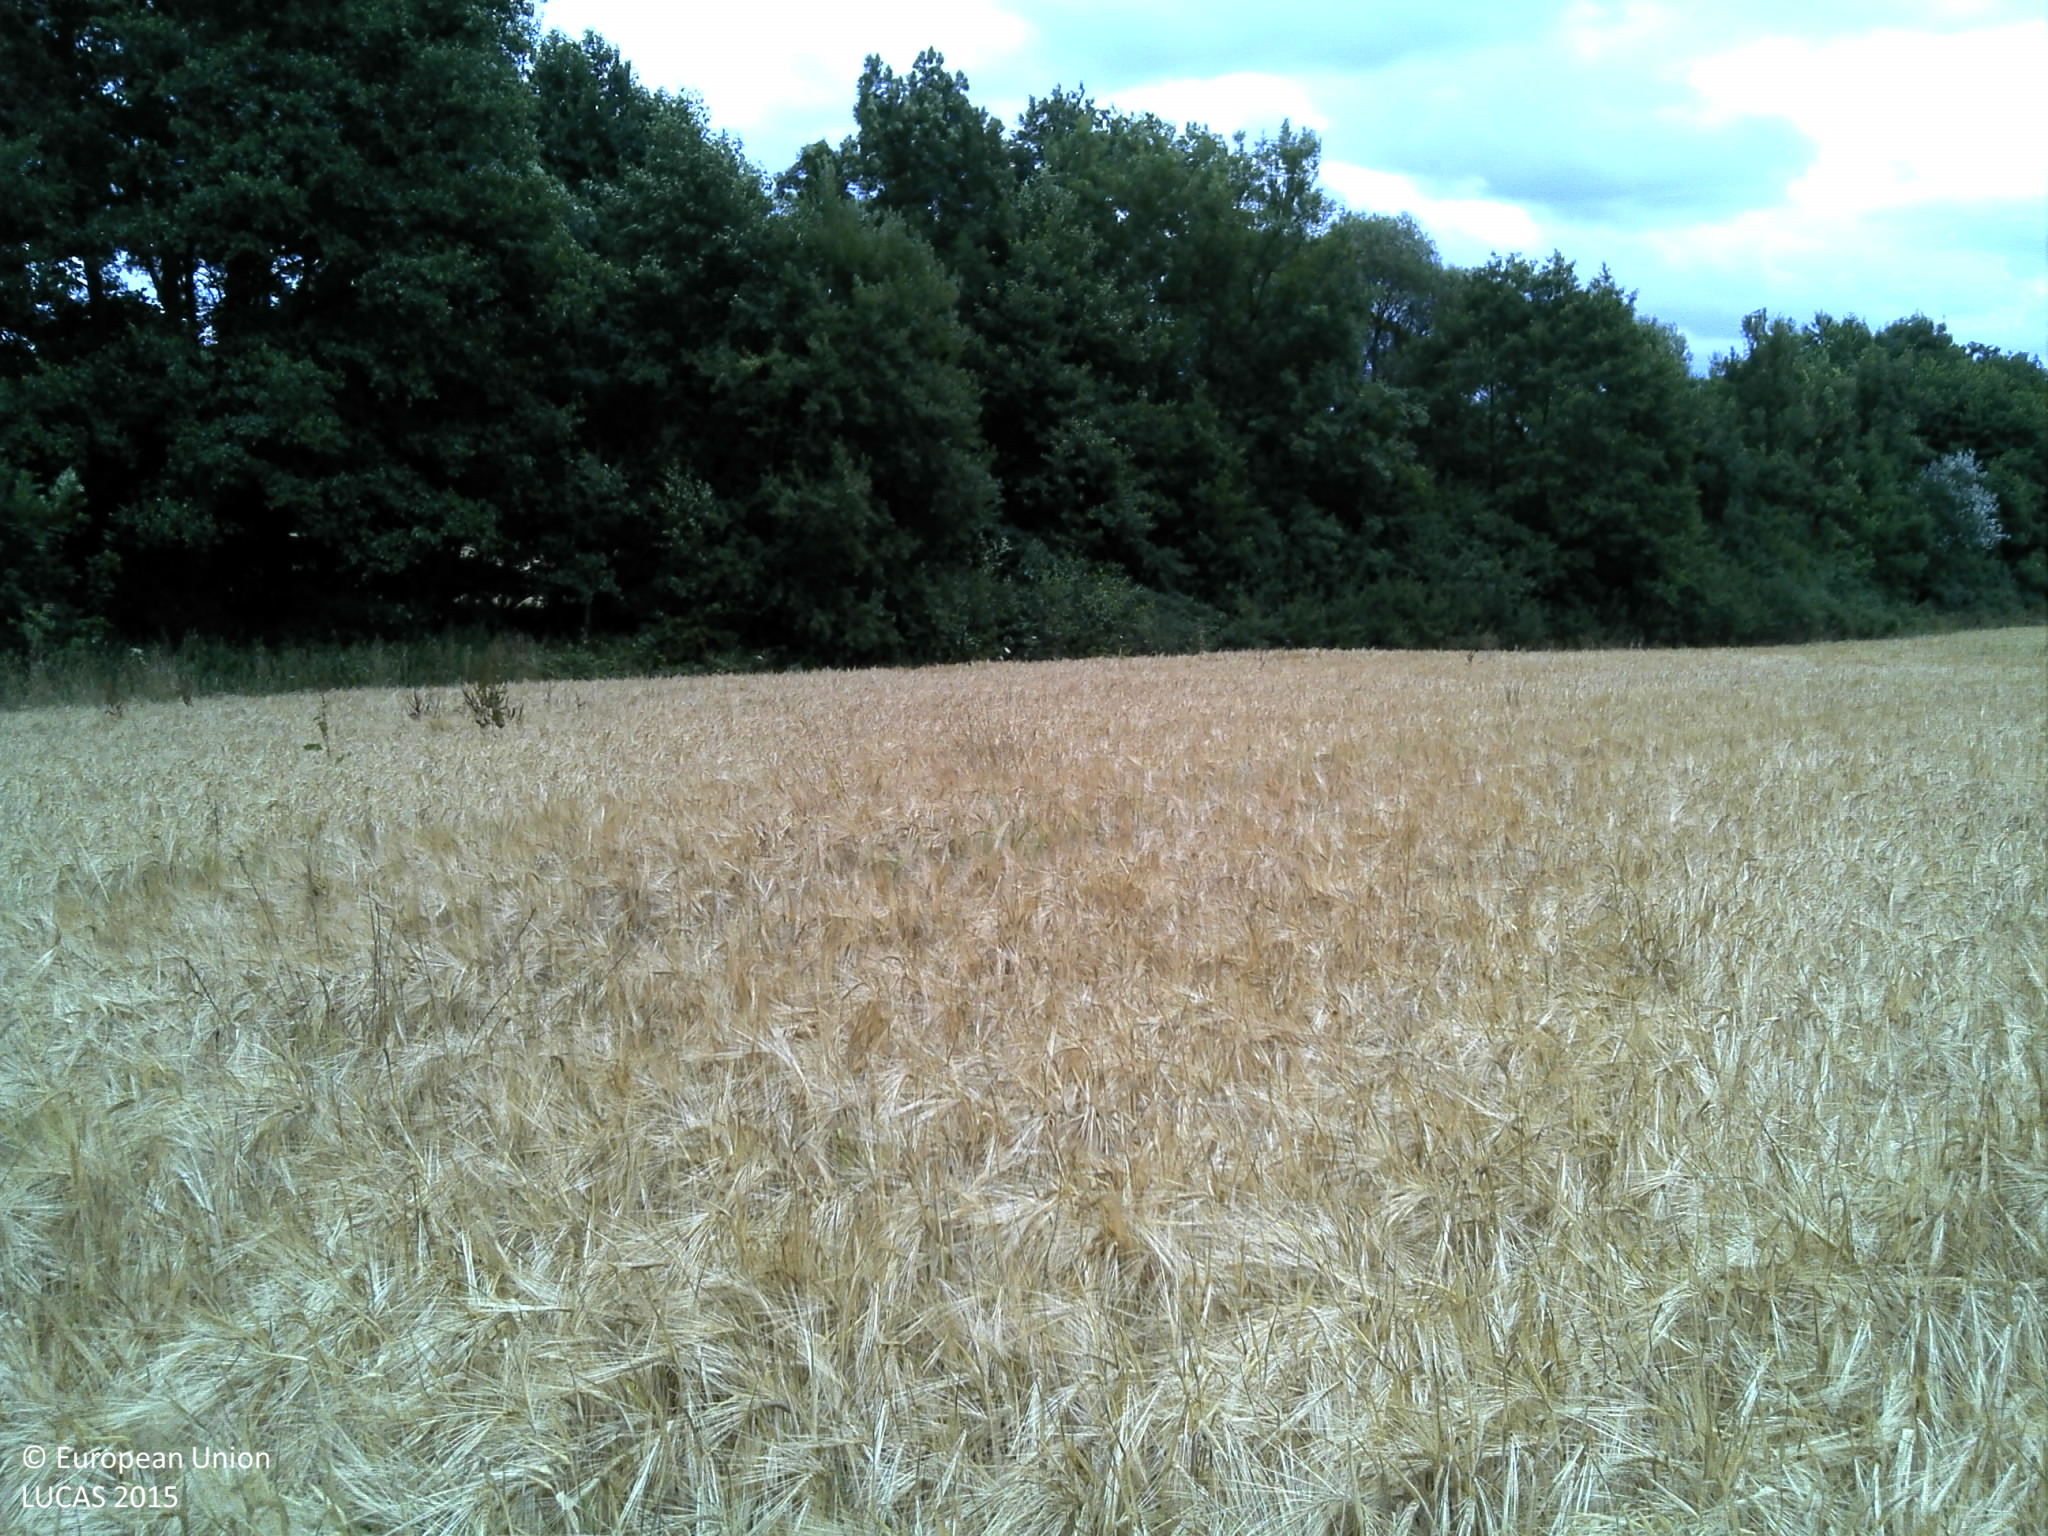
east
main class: Cropland
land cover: Rye
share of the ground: > 75 %
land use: Agriculture (excluding fallow land and kitchen gardens)
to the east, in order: Rye; Broadleaved woodland; Rivers and streams; Grass margins; Common wheat; Electric lines; Common wheat
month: July
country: FR
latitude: 49.1862
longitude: 4.8798
